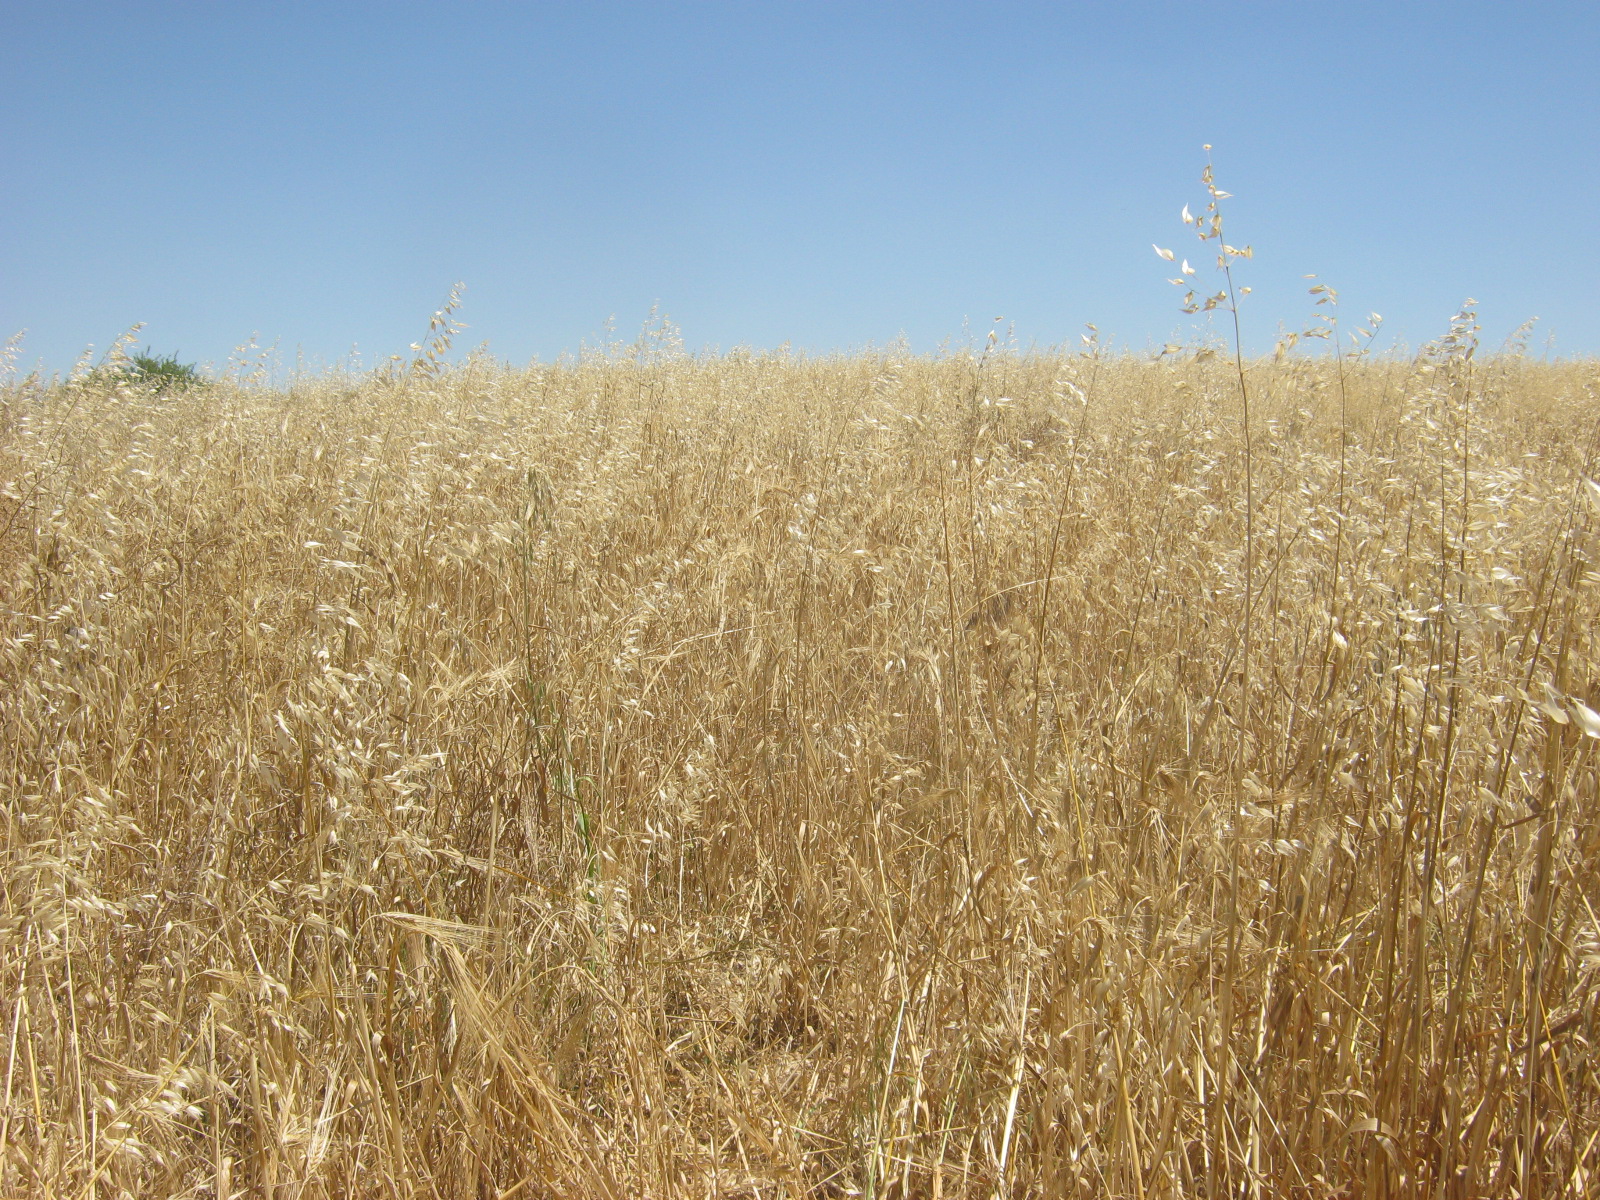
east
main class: Cropland
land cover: Barley
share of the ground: > 75 %
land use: Agriculture (excluding fallow land and kitchen gardens)
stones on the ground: 10 - 25 %
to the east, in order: Barley; Grassland without tree/shrub cover; Barley
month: May
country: CY
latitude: 35.1082
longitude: 33.2374
